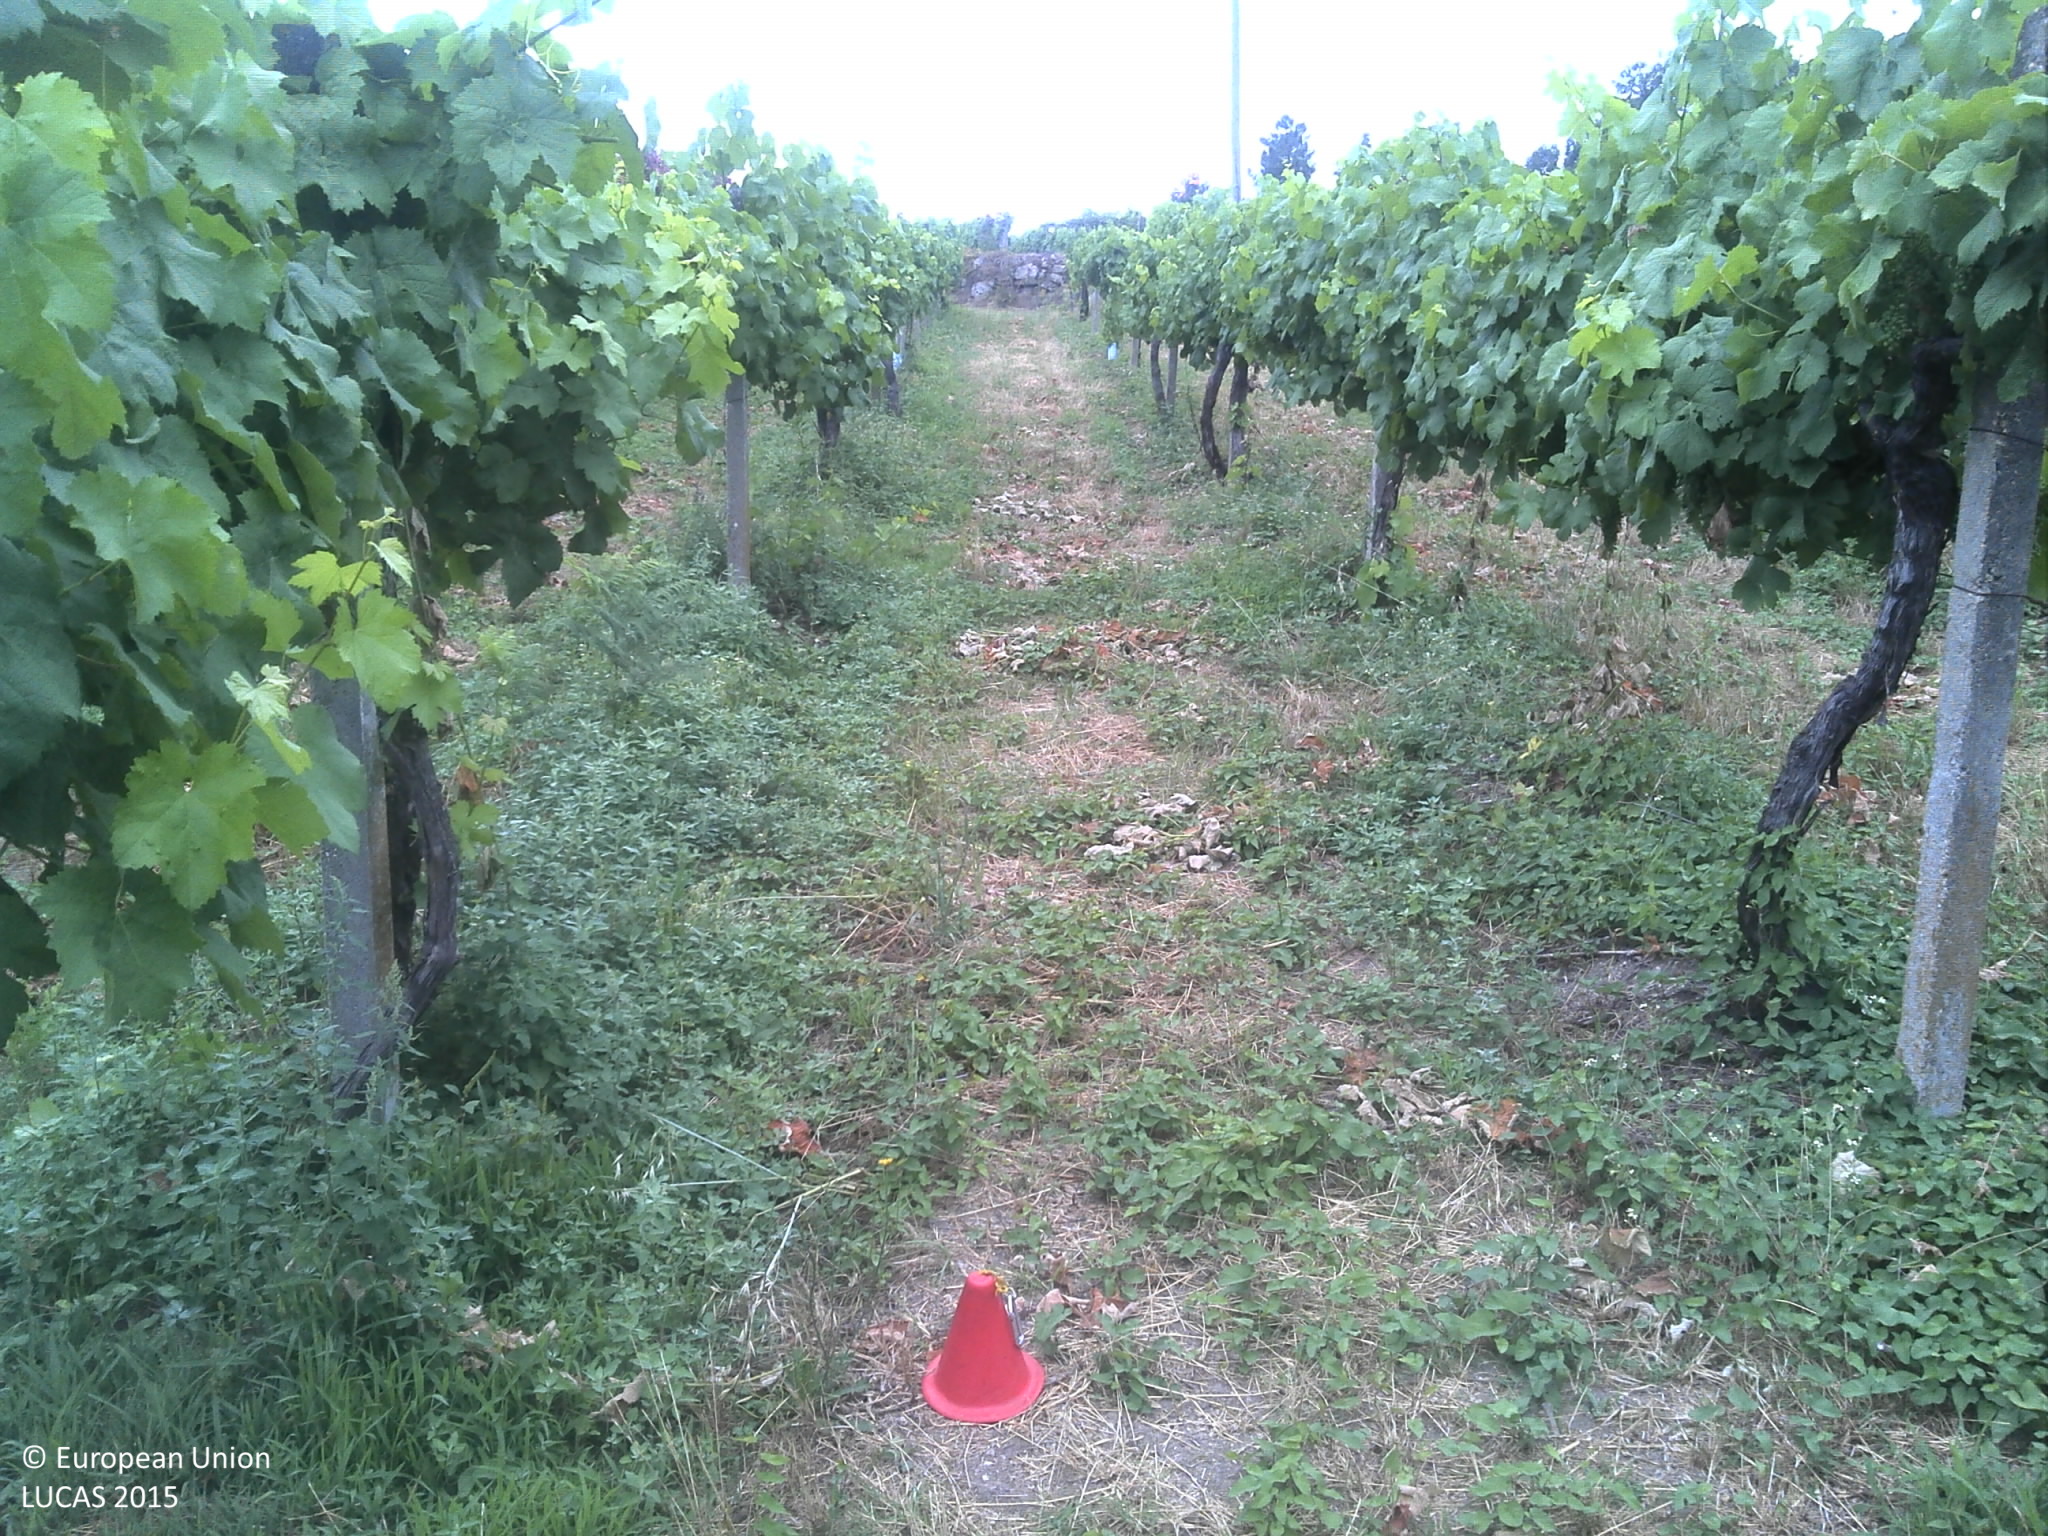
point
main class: Cropland
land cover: Vineyards
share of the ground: 25 - 50 %
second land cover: Grassland without tree/shrub cover
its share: 50 - 75 %
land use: Agriculture (excluding fallow land and kitchen gardens)
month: June
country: PT
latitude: 41.2345
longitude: -8.1687
